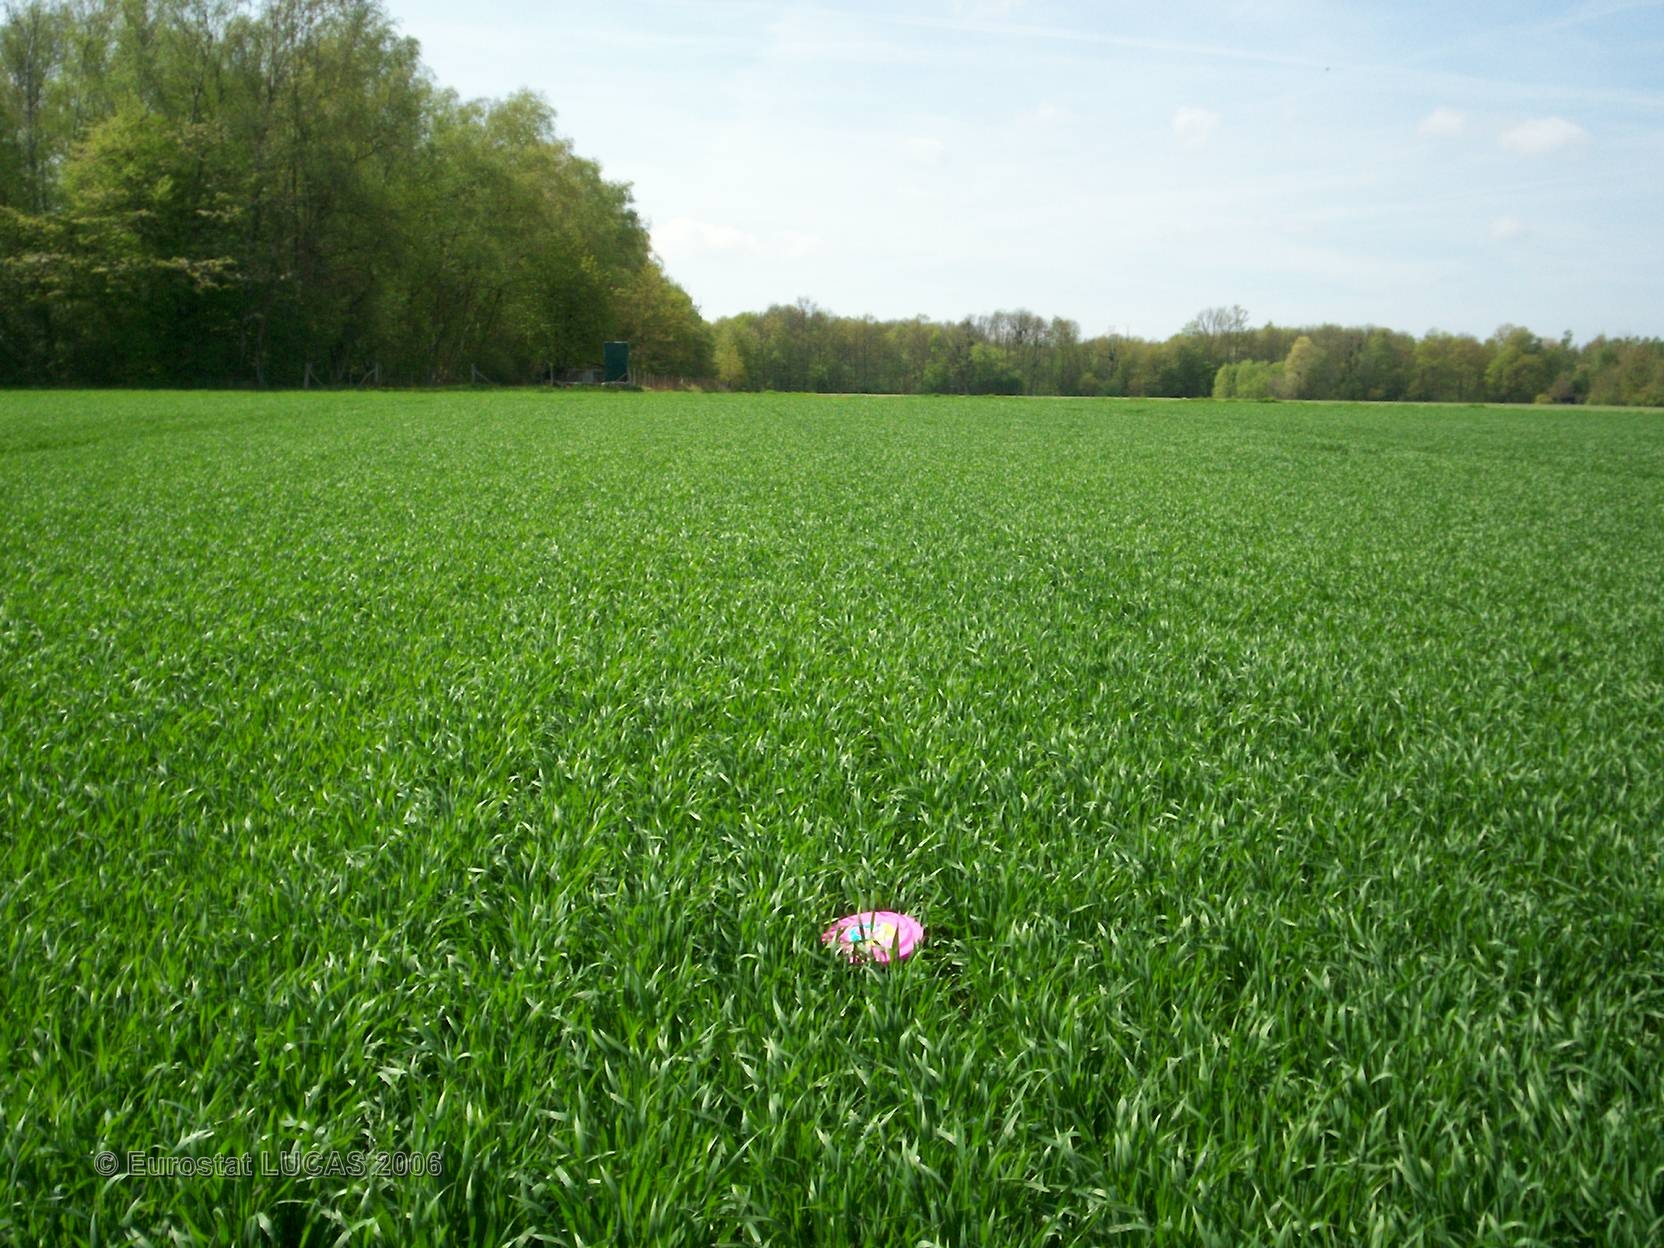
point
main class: Cropland
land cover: Common wheat
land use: Agriculture (excluding fallow land and kitchen gardens)
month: May
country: FR
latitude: 48.8411
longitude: 2.8645
